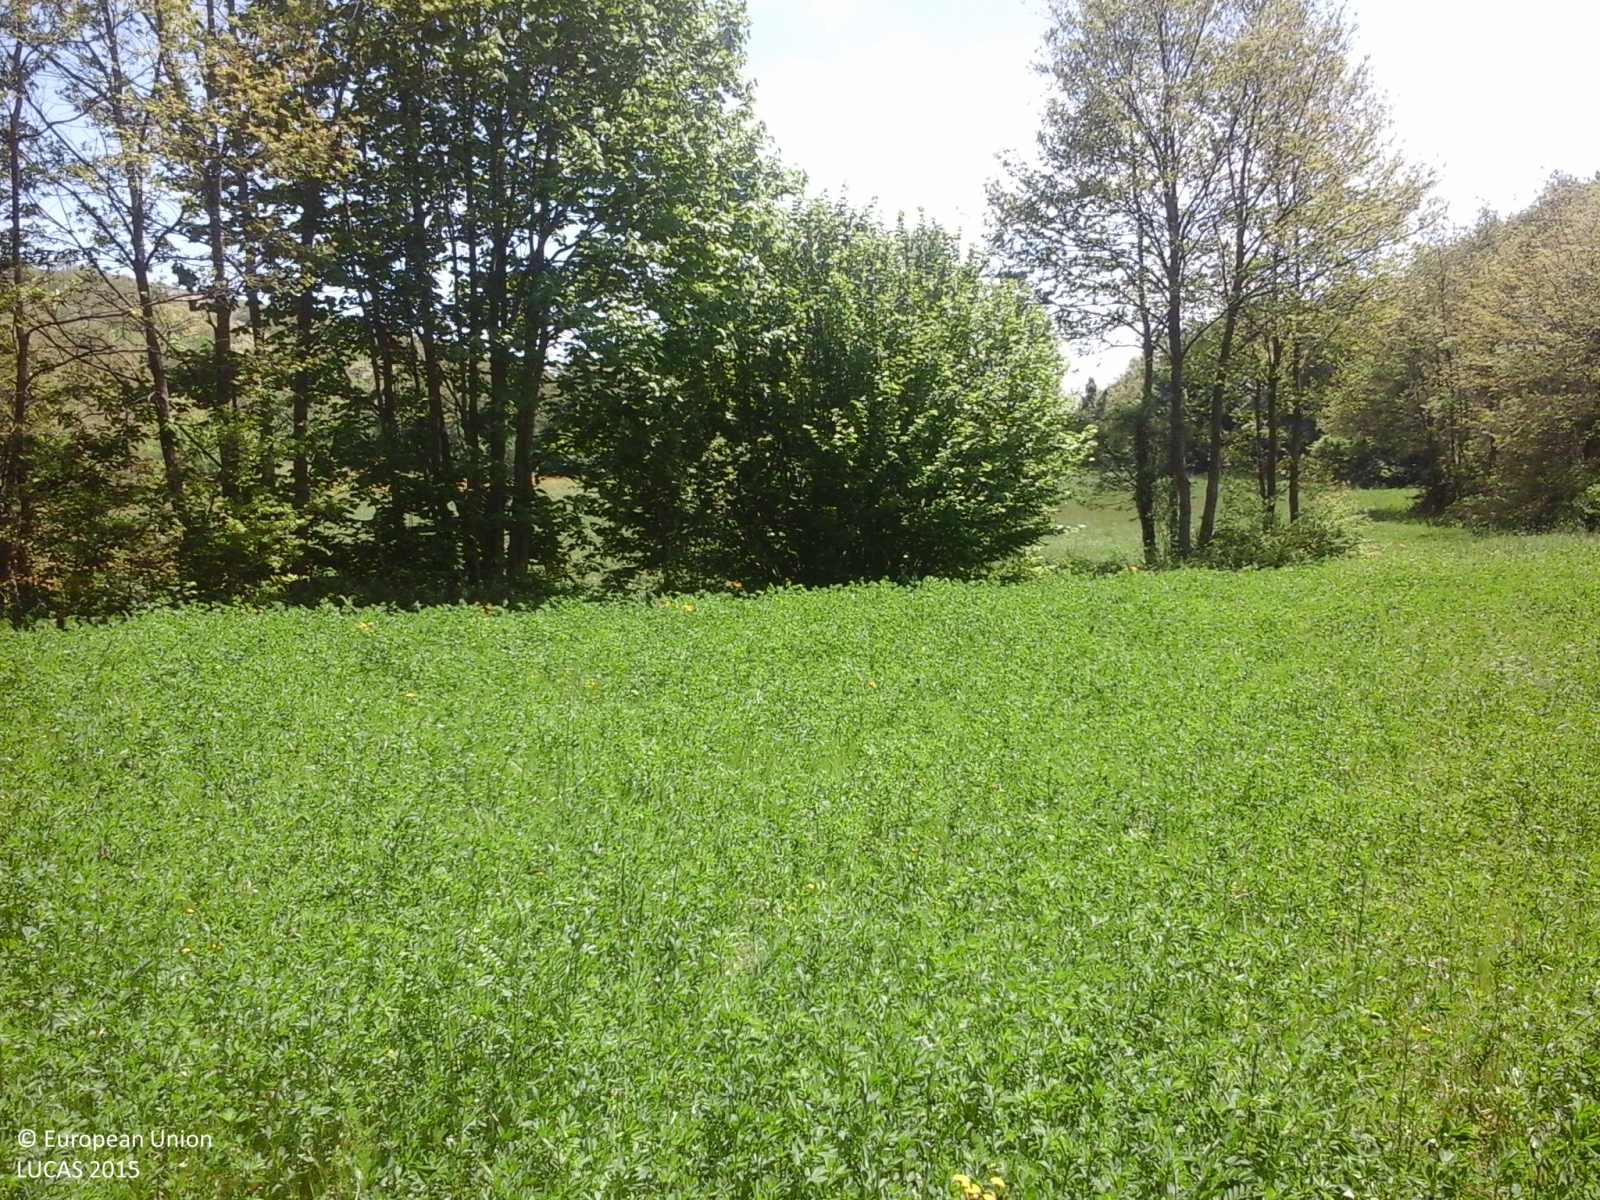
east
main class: Woodland
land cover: Broadleaved woodland
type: thermophilous deciduous forest
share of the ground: > 75 %
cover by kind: broadleaved forest trees 100 %
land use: Forestry
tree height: > 5 m
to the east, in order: Broadleaved woodland
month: May
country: IT
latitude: 41.3164
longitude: 14.6537
